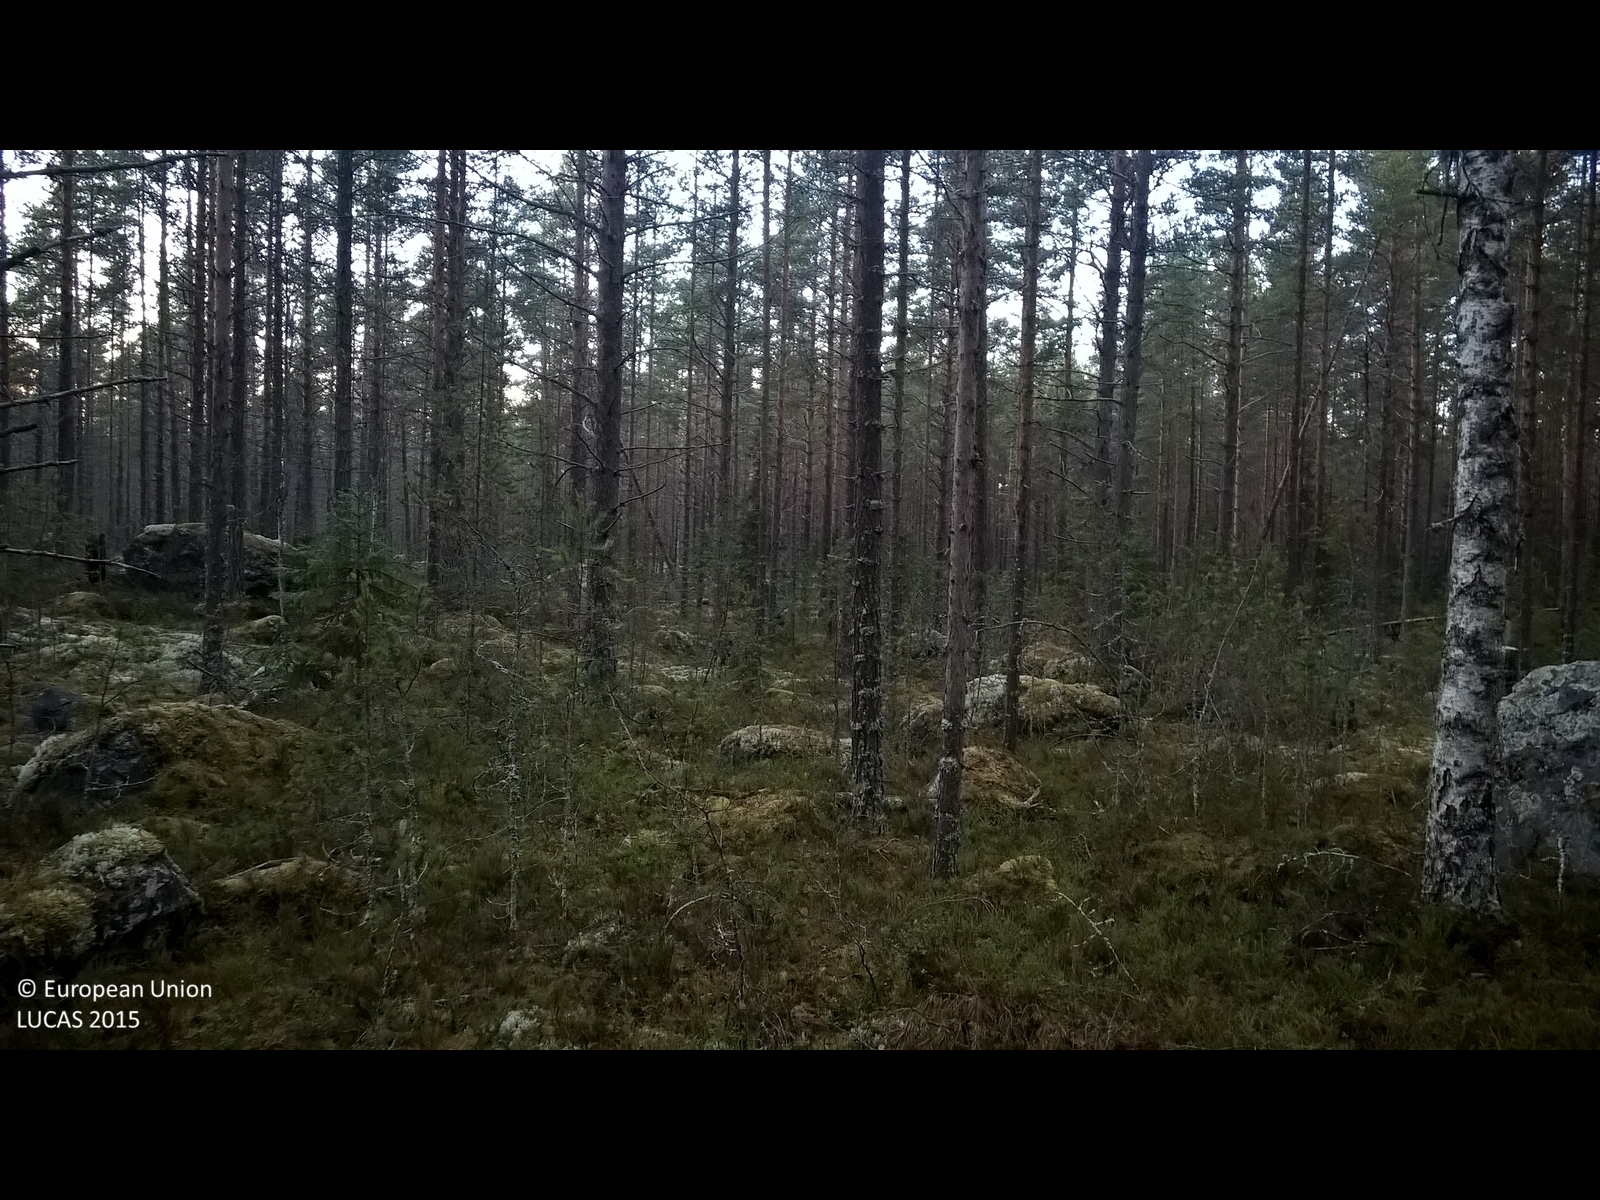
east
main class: Woodland
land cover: Pine dominated coniferous woodland
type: boreal forest
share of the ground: > 75 %
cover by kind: coniferous forest trees 80 %, shrubs 10 %, lichens and mosses 10 %
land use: Forestry
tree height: > 5 m
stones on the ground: < 10 %
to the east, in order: Pine dominated coniferous woodland; Broadleaved woodland; Groves; Paved roads, cycling and walking lanes; Groves; Pine dominated coniferous woodland
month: November
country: SE
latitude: 62.4631
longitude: 15.3507
